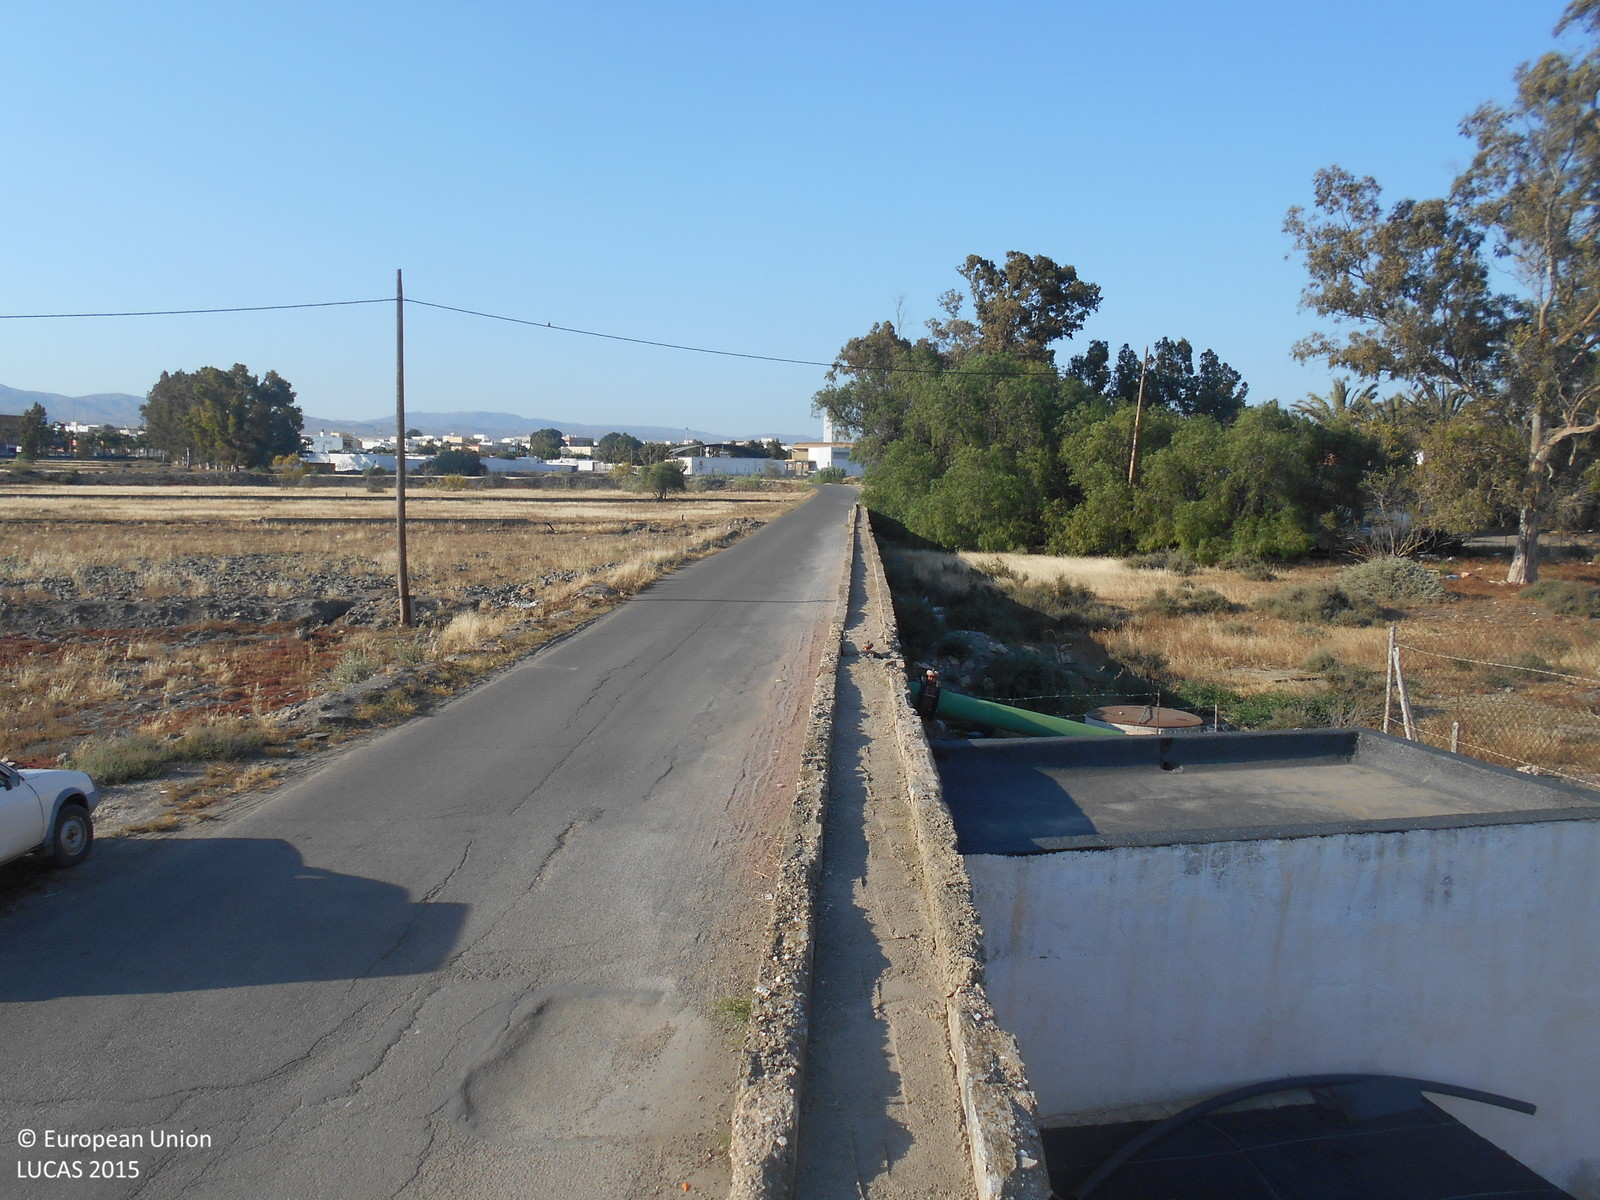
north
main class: Artificial land
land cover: Greenhouses
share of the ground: > 75 %
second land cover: Other fresh vegetables
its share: > 75 %
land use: Agriculture (excluding fallow land and kitchen gardens)
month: May
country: ES
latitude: 36.9309
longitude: -2.1333
